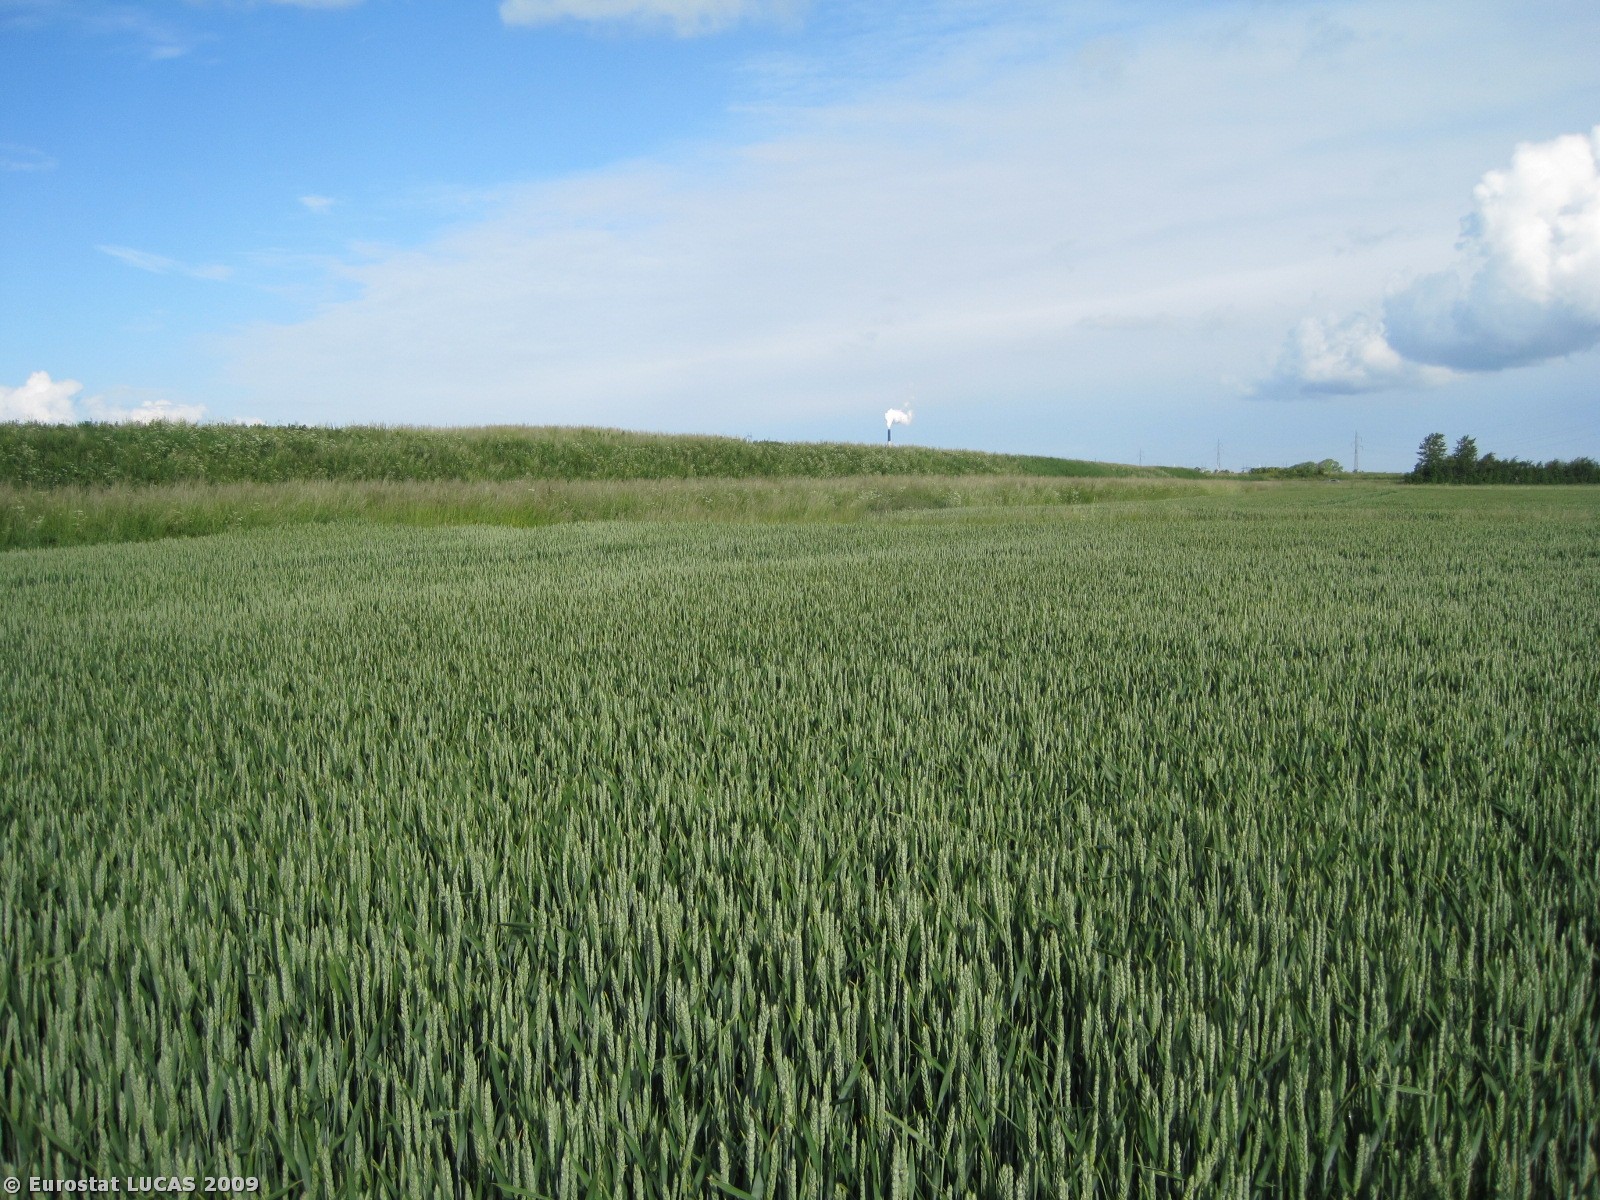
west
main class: Cropland
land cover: Common wheat
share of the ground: > 75 %
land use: Agriculture (excluding fallow land and kitchen gardens)
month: June
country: DK
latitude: 57.0506
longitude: 10.1152
